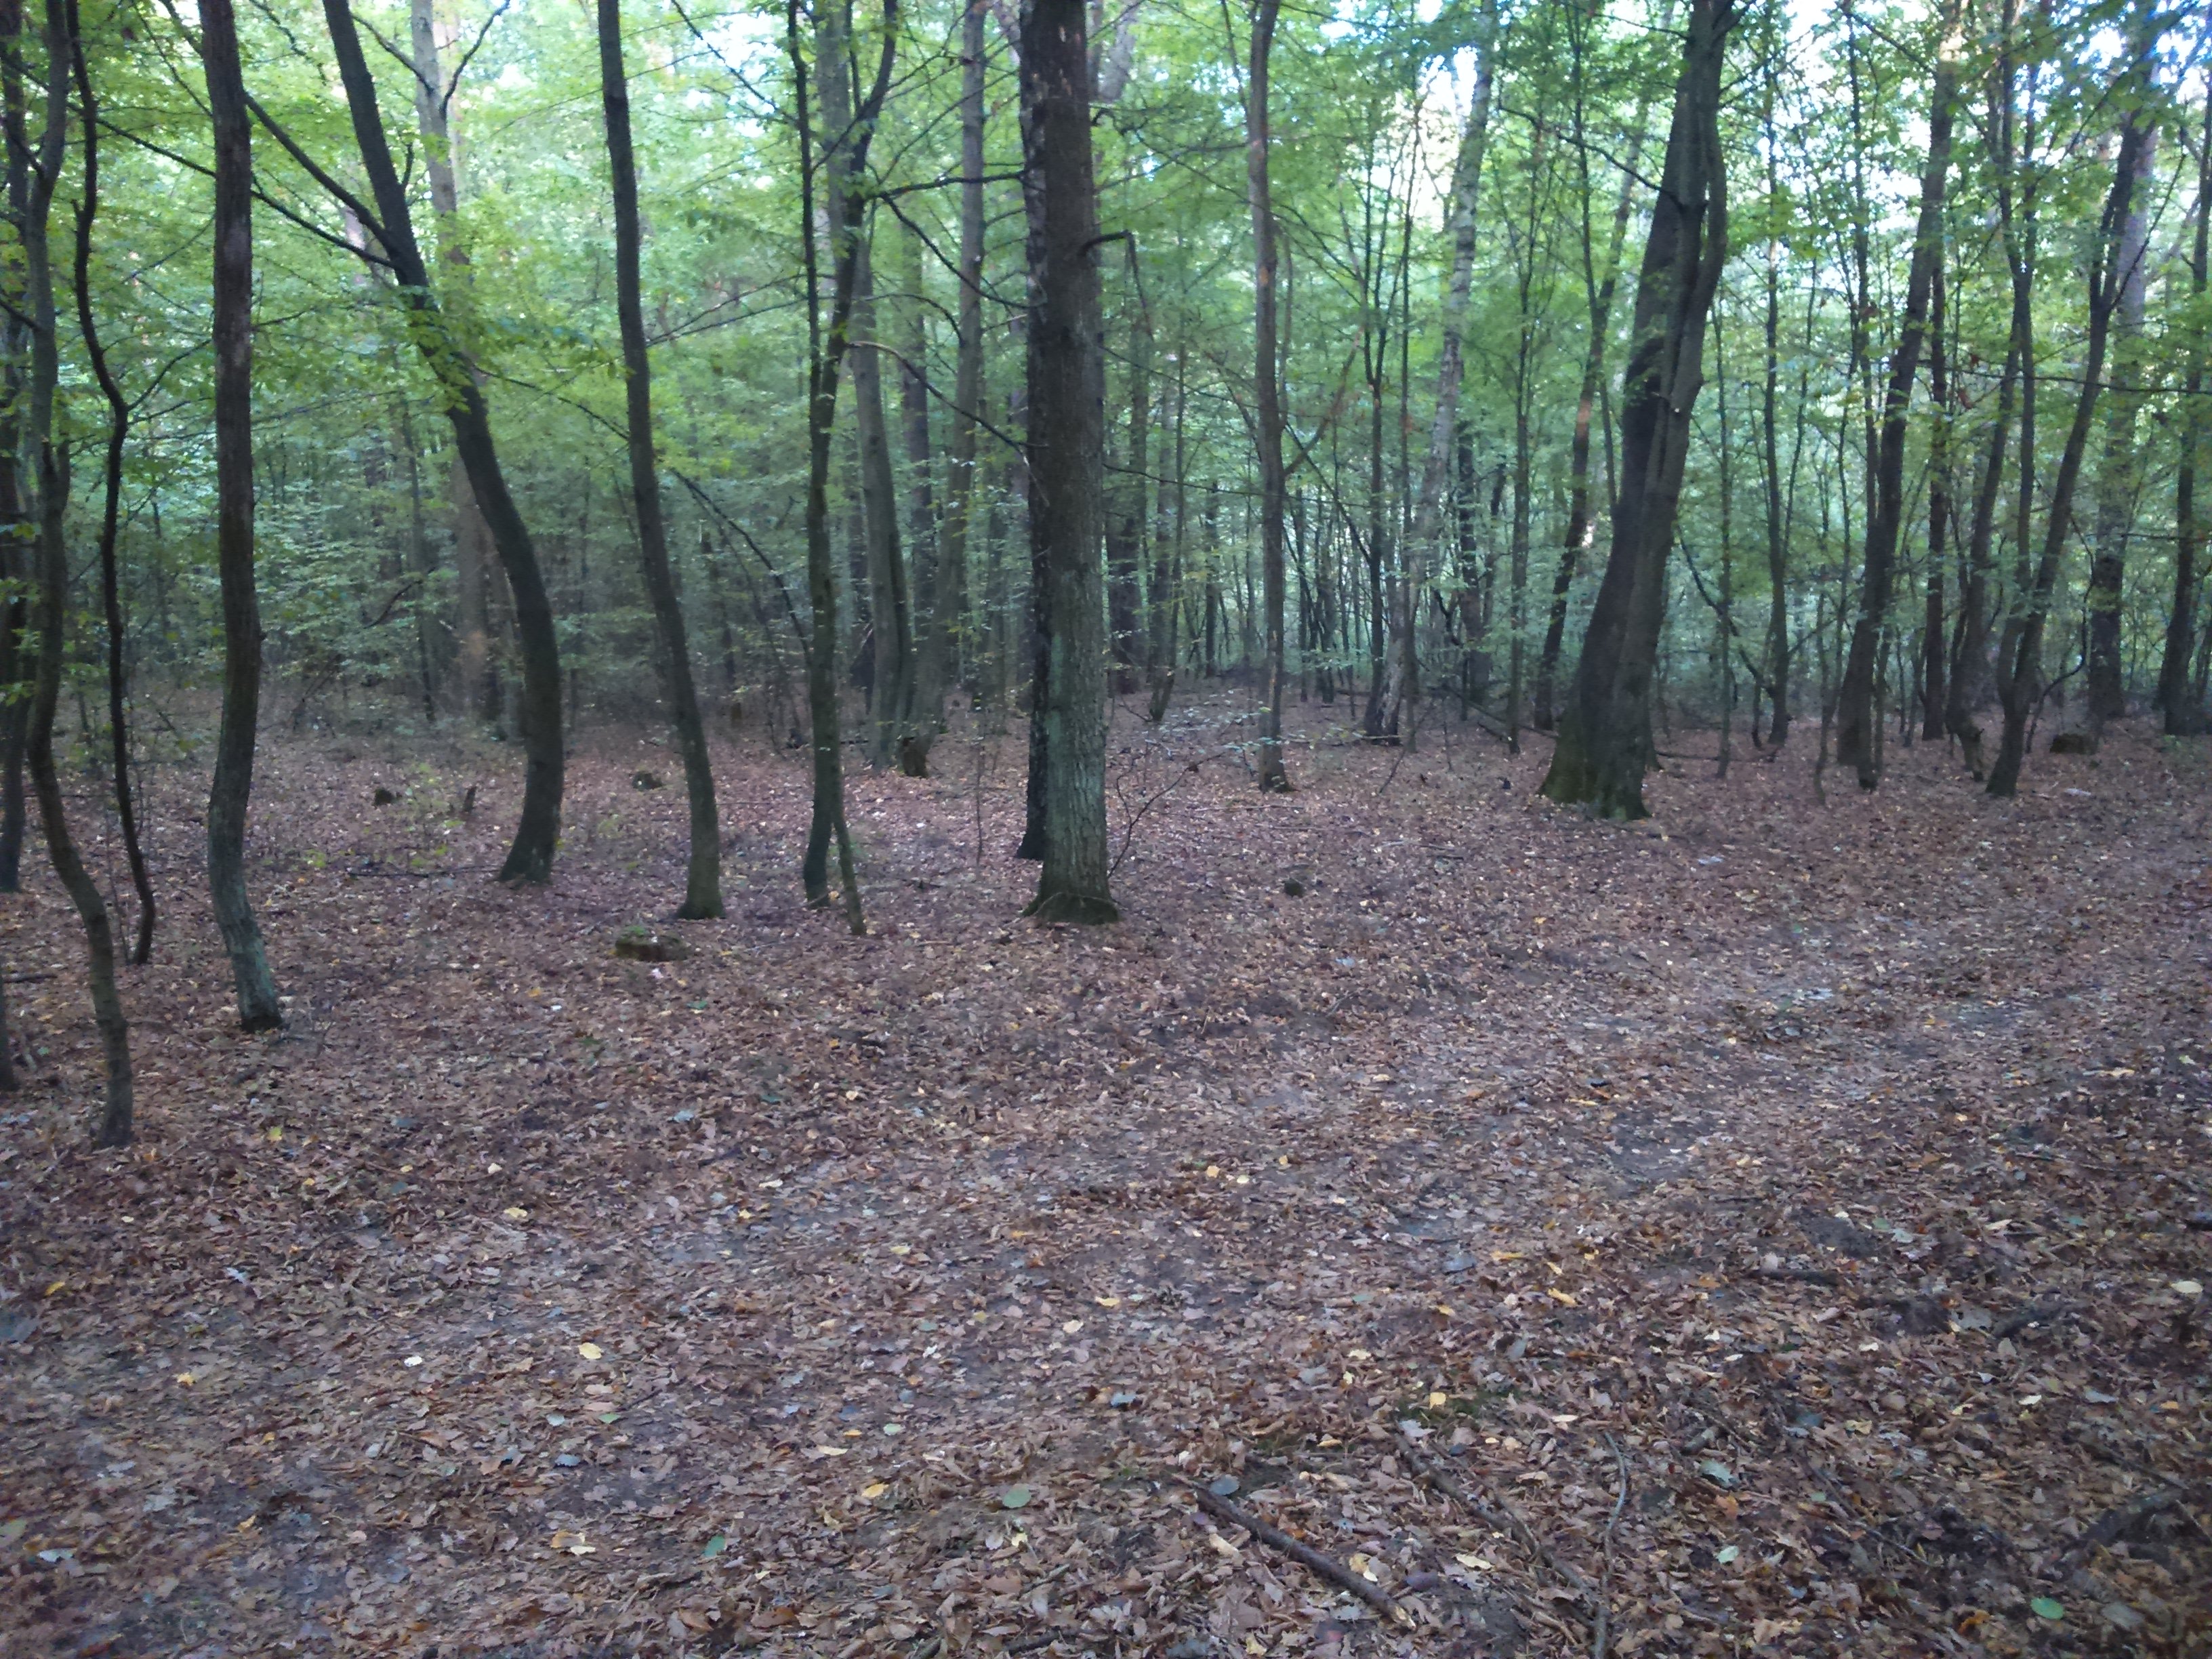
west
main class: Woodland
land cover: Broadleaved woodland
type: mesophytic deciduous forest
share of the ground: > 75 %
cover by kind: broadleaved forest trees 100 %
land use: Forestry
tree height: > 5 m
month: September
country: PL
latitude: 52.3427
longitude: 21.8725
